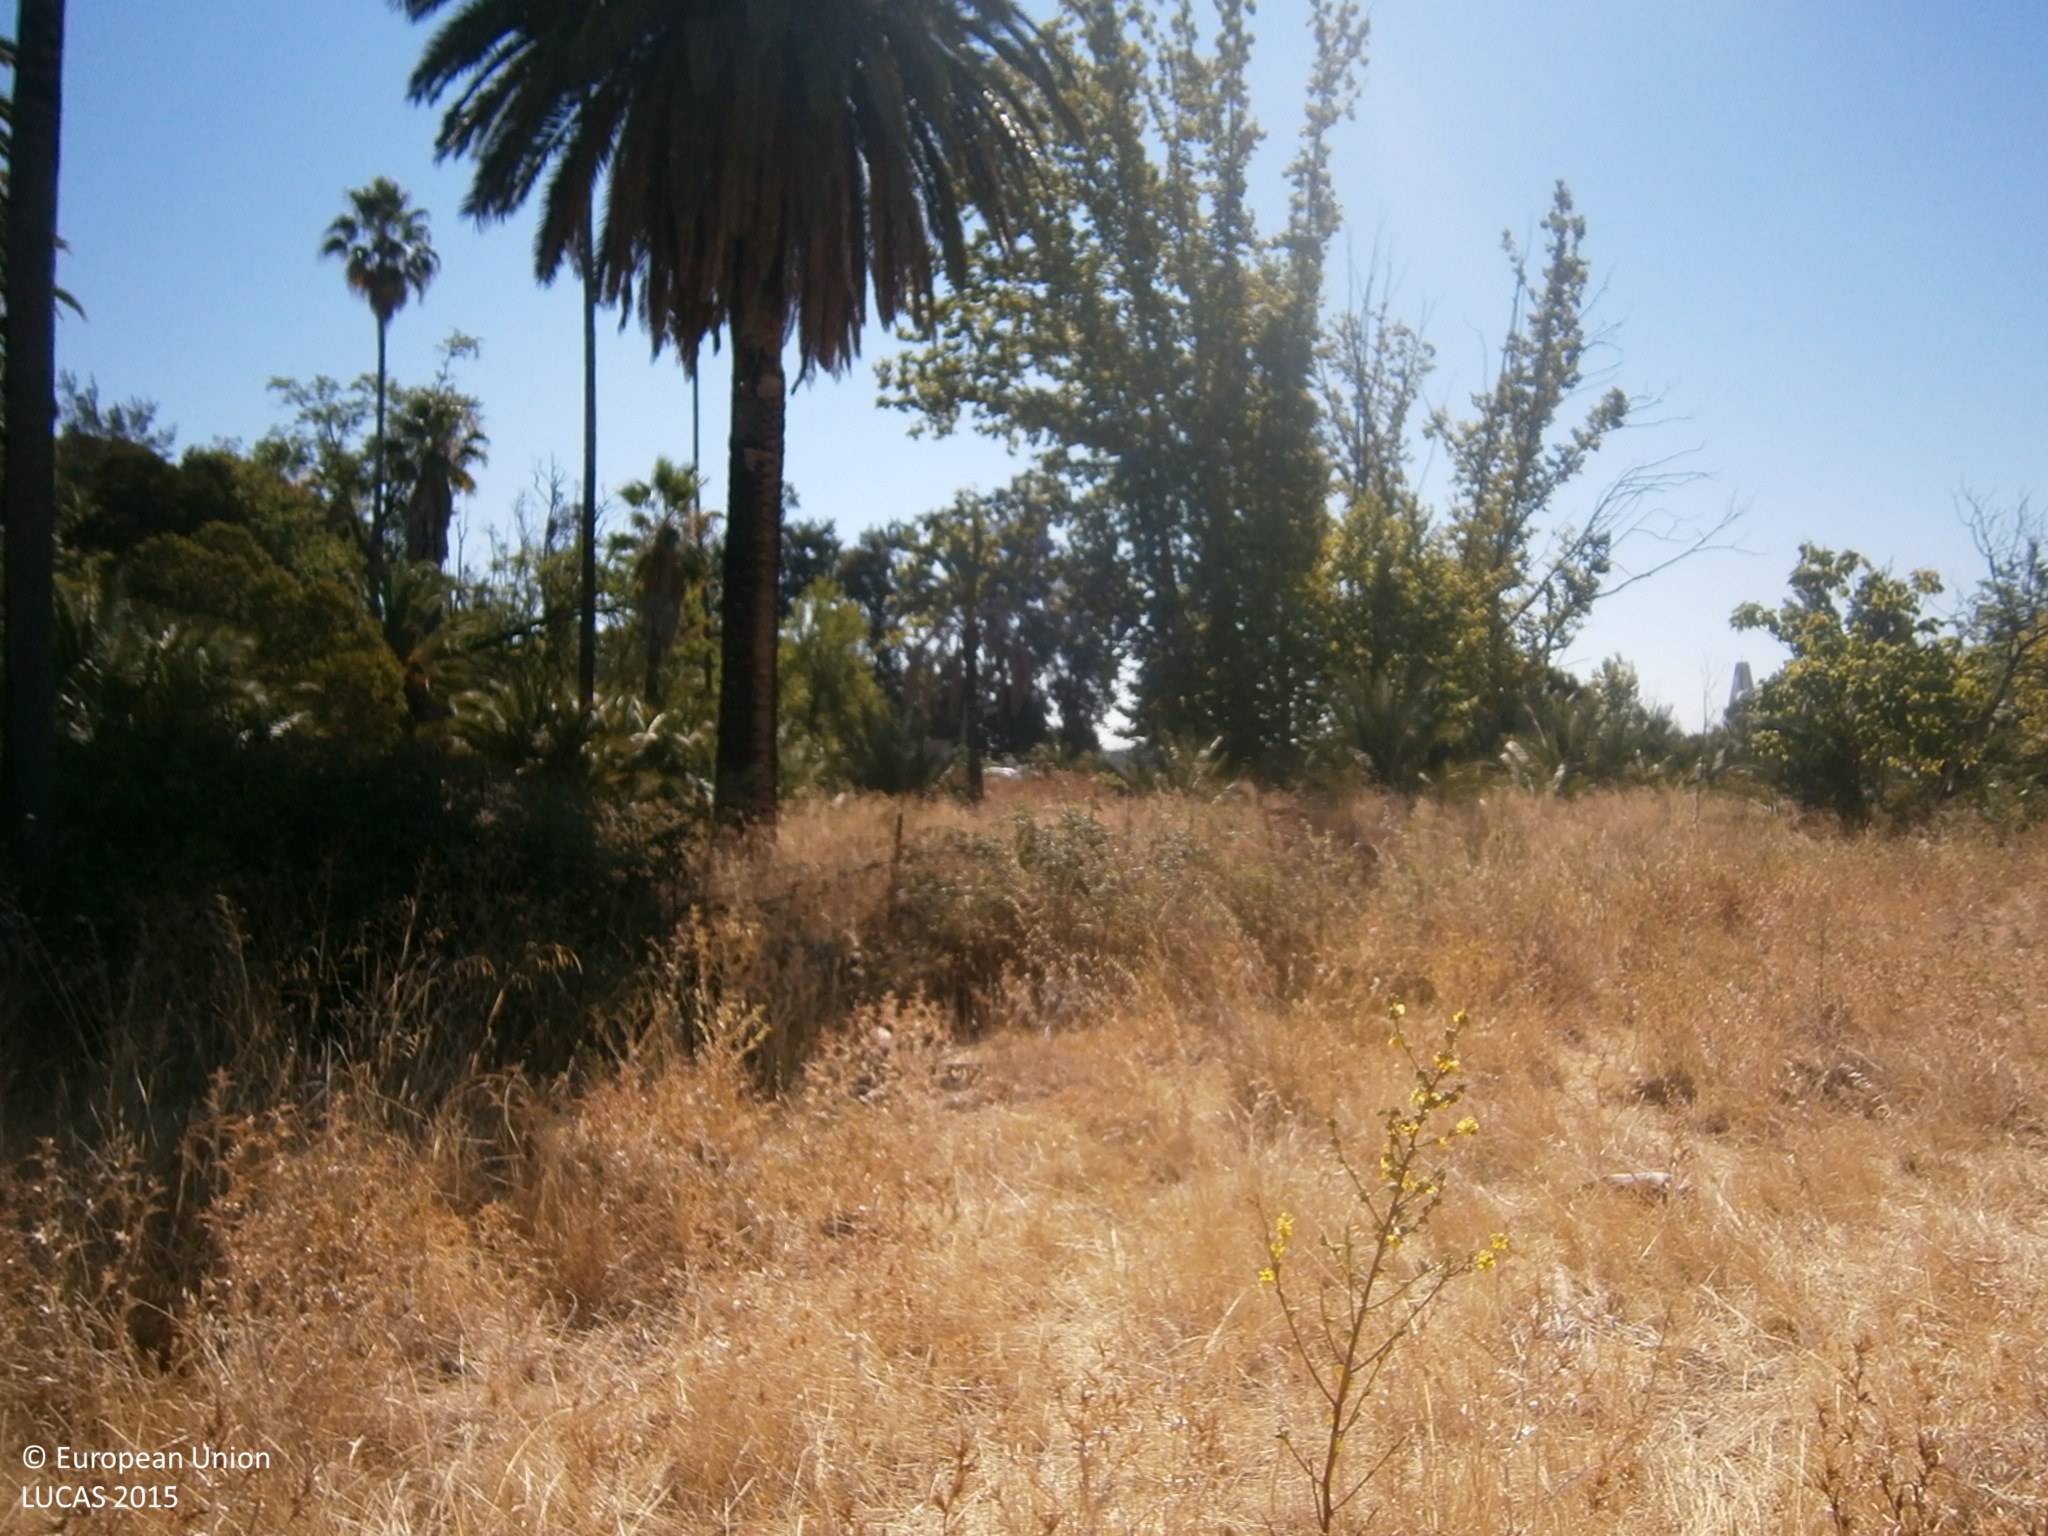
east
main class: Grassland
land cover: Grassland with sparse tree/shrub cover
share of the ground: > 75 %
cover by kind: herbaceous plants 90 %, coniferous forest trees 5 %, shrubs 5 %
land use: Agriculture (excluding fallow land and kitchen gardens)
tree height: > 5 m
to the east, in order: Grassland with sparse tree/shrub cover; Fences; Broadleaved woodland; Artificial constructions in urban areas; Abandoned hedges; Grassland with sparse tree/shrub cover
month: July
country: ES
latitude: 38.8813
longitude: -7.0044
